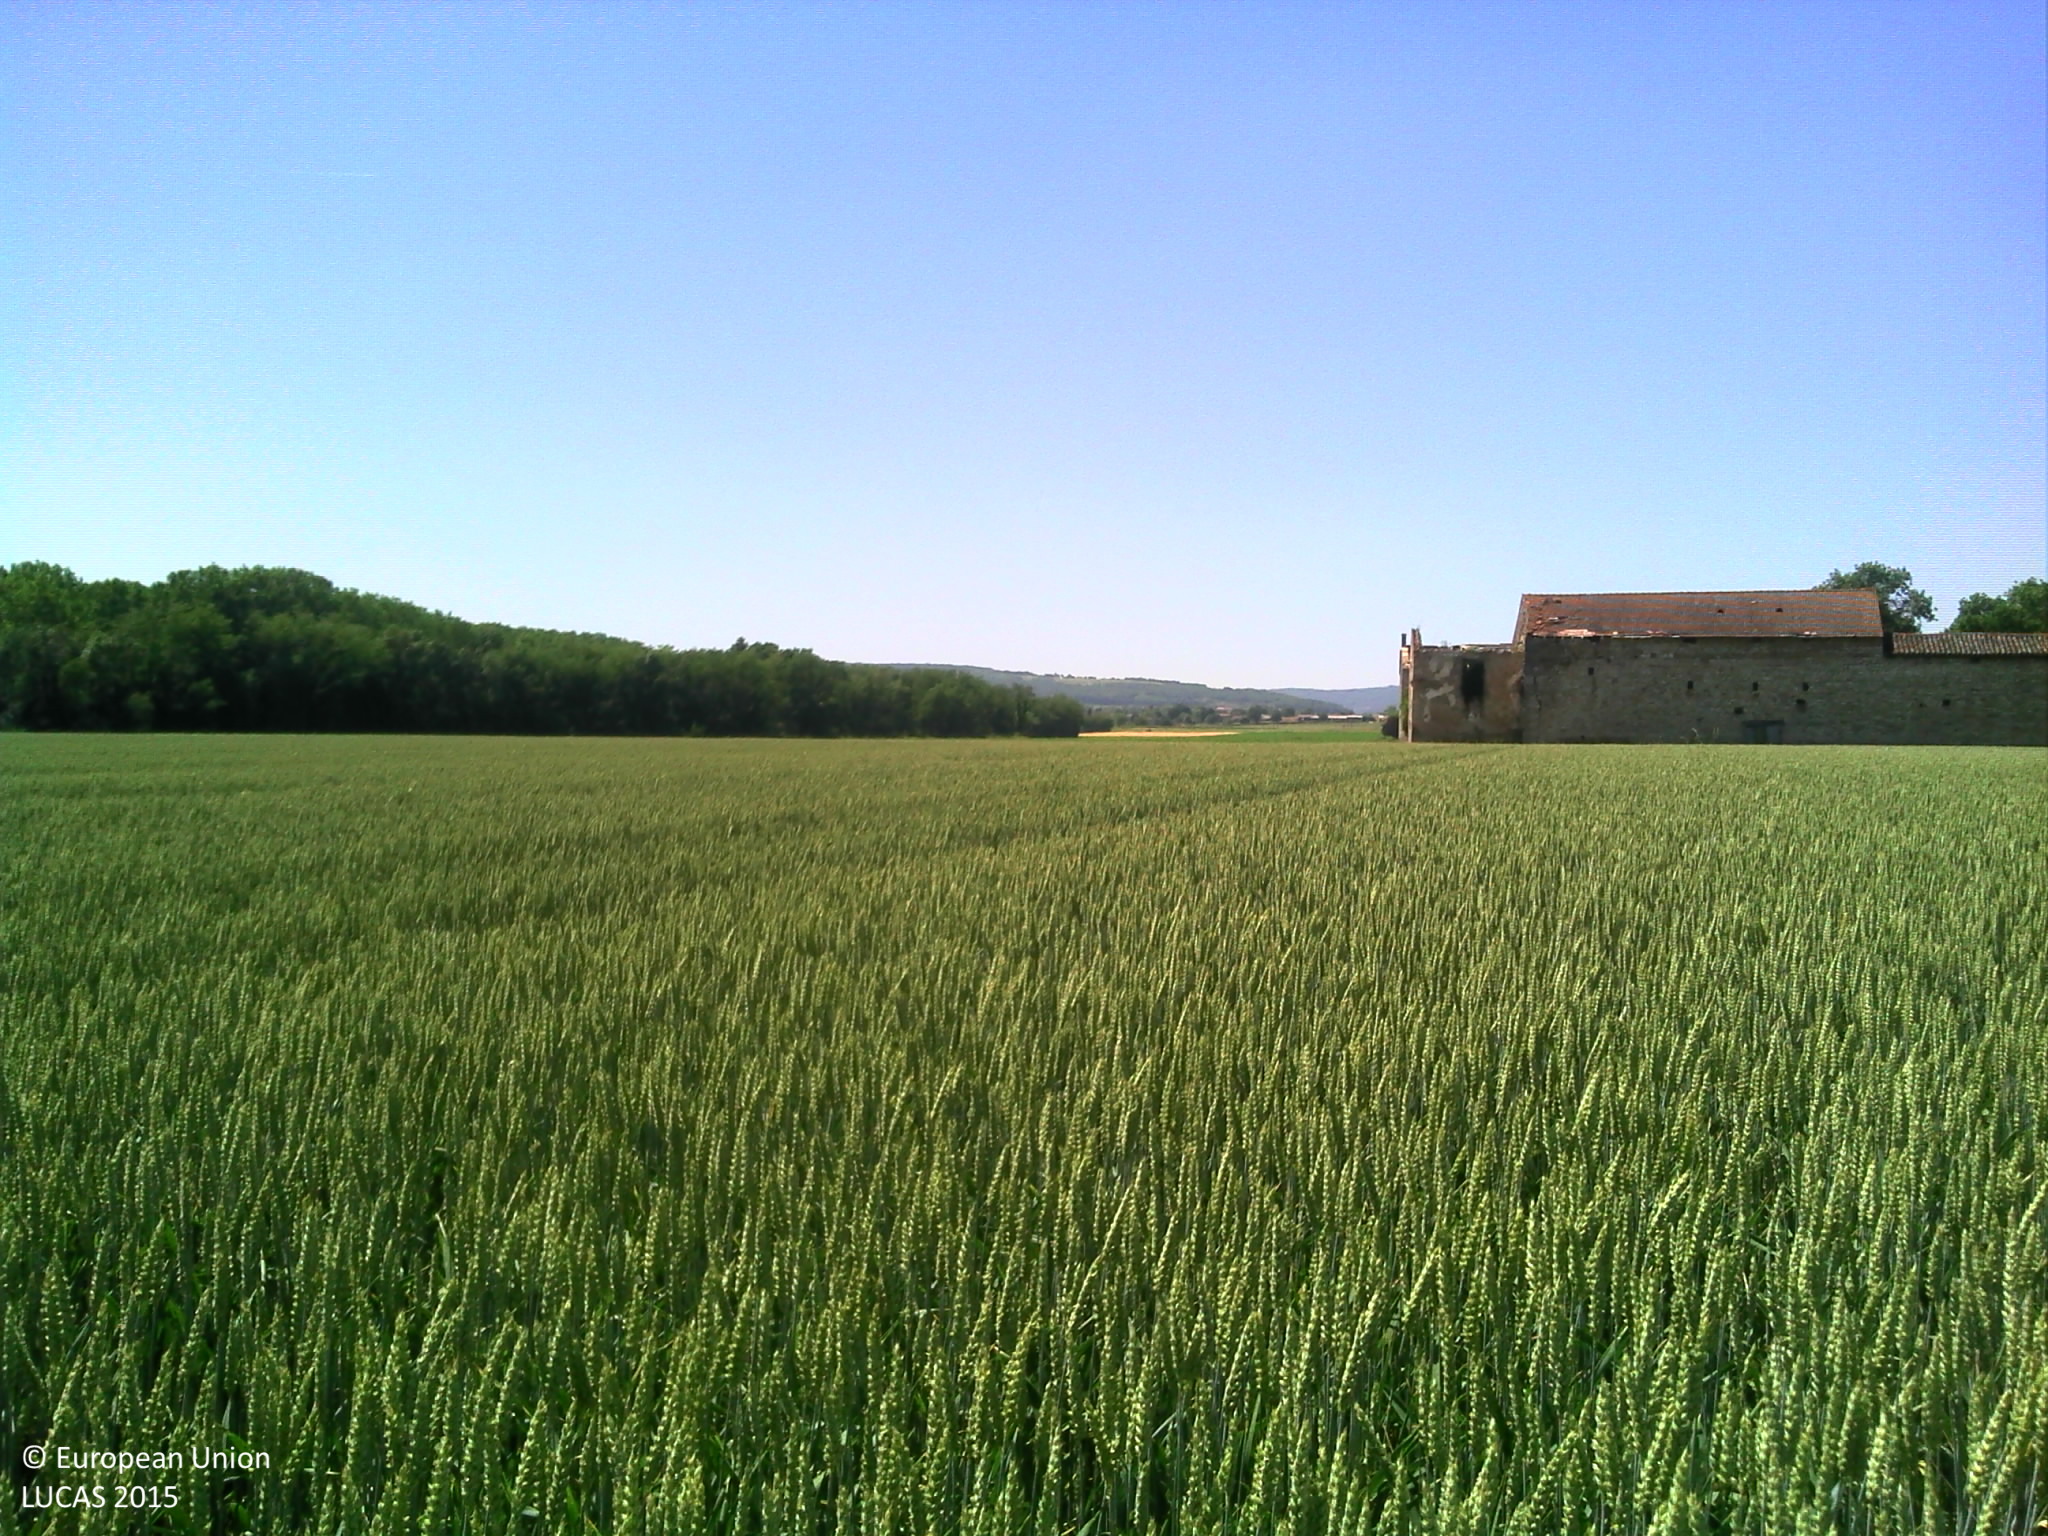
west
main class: Cropland
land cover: Common wheat
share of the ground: > 75 %
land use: Agriculture (excluding fallow land and kitchen gardens)
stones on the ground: < 10 %
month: June
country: FR
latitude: 46.4647
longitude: 4.9105
